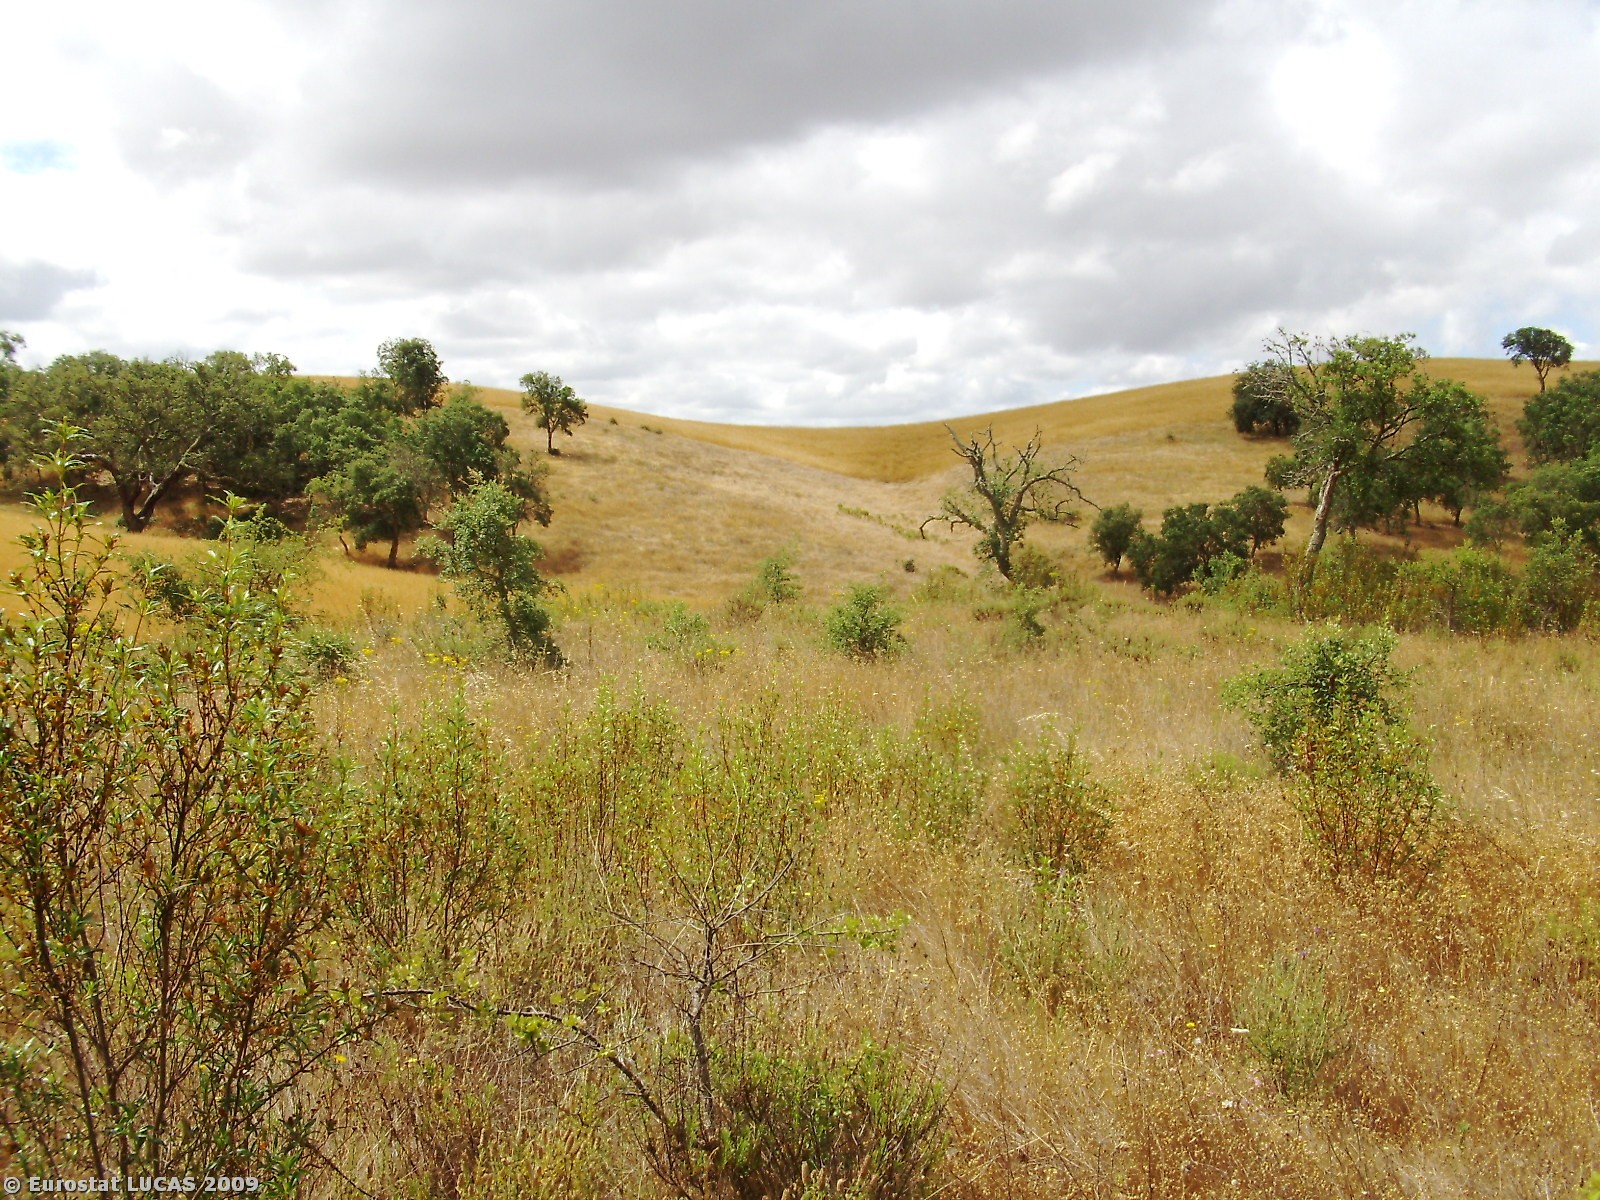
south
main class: Woodland
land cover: Broadleaved woodland
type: broadleaved evergreen forest
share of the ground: 10 - 25 %
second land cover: Shrubland with sparse tree cover
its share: 25 - 50 %
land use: Forestry
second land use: Fallow land
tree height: > 5 m
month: June
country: PT
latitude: 37.8327
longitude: -8.6431
